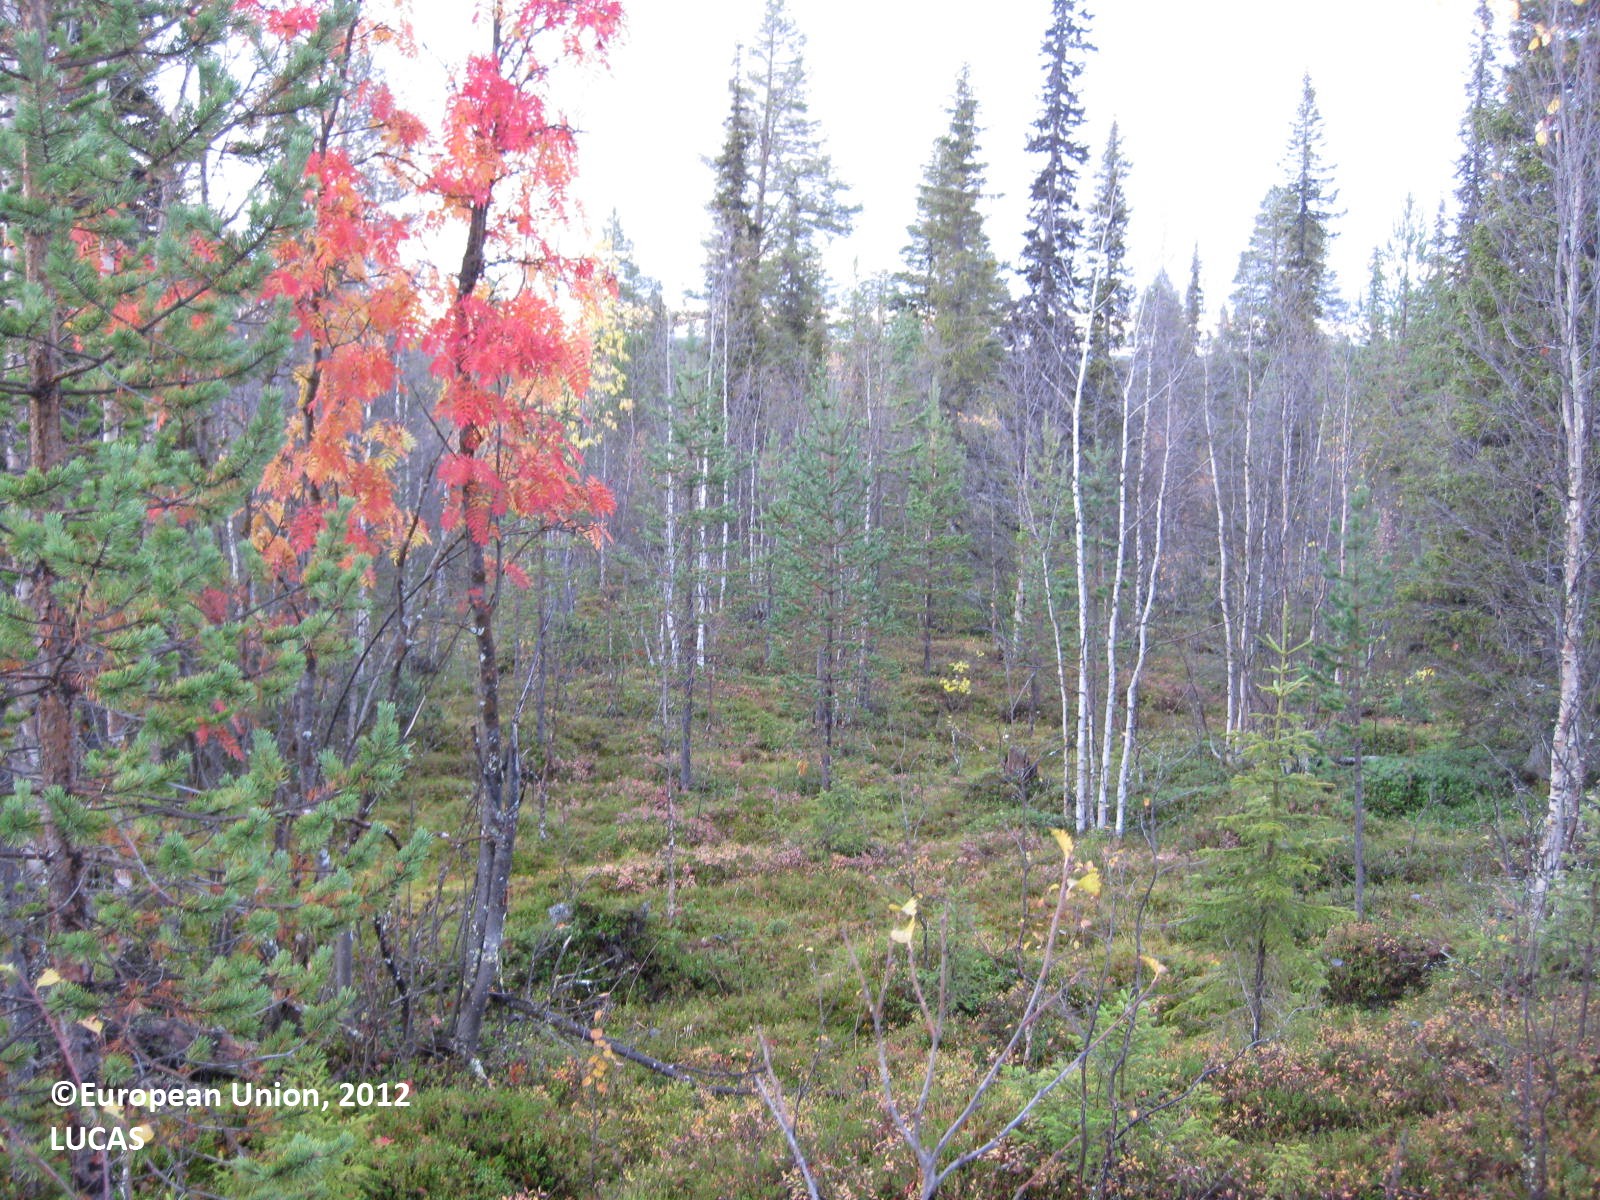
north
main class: Woodland
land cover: Other mixed woodland
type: boreal forest
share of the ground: 25 - 50 %
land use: Semi-natural and natural areas not in use
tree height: > 5 m
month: September
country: FI
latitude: 68.1526
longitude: 24.1504
